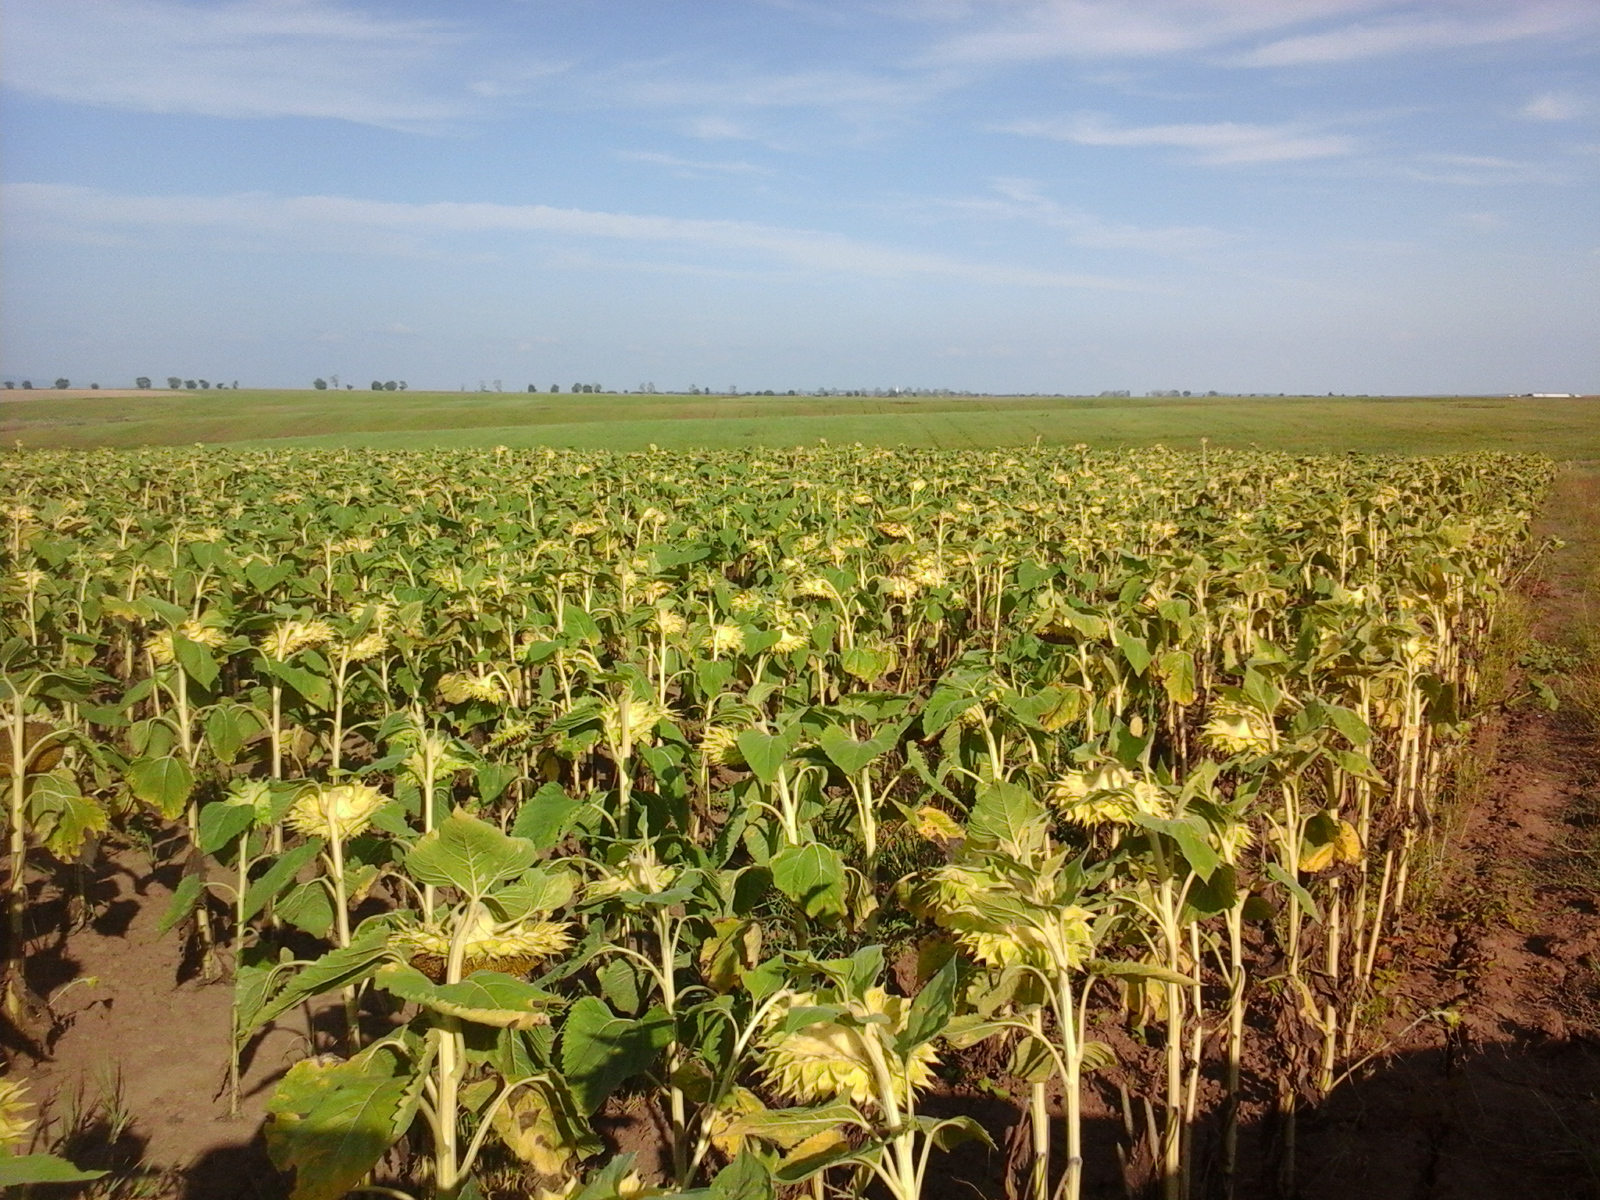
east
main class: Cropland
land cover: Sunflower
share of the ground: > 75 %
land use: Agriculture (excluding fallow land and kitchen gardens)
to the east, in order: Sunflower; Grass margins; Tracks; Spontaneously vegetated surfaces
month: August
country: RO
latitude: 46.0370
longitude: 21.3393
